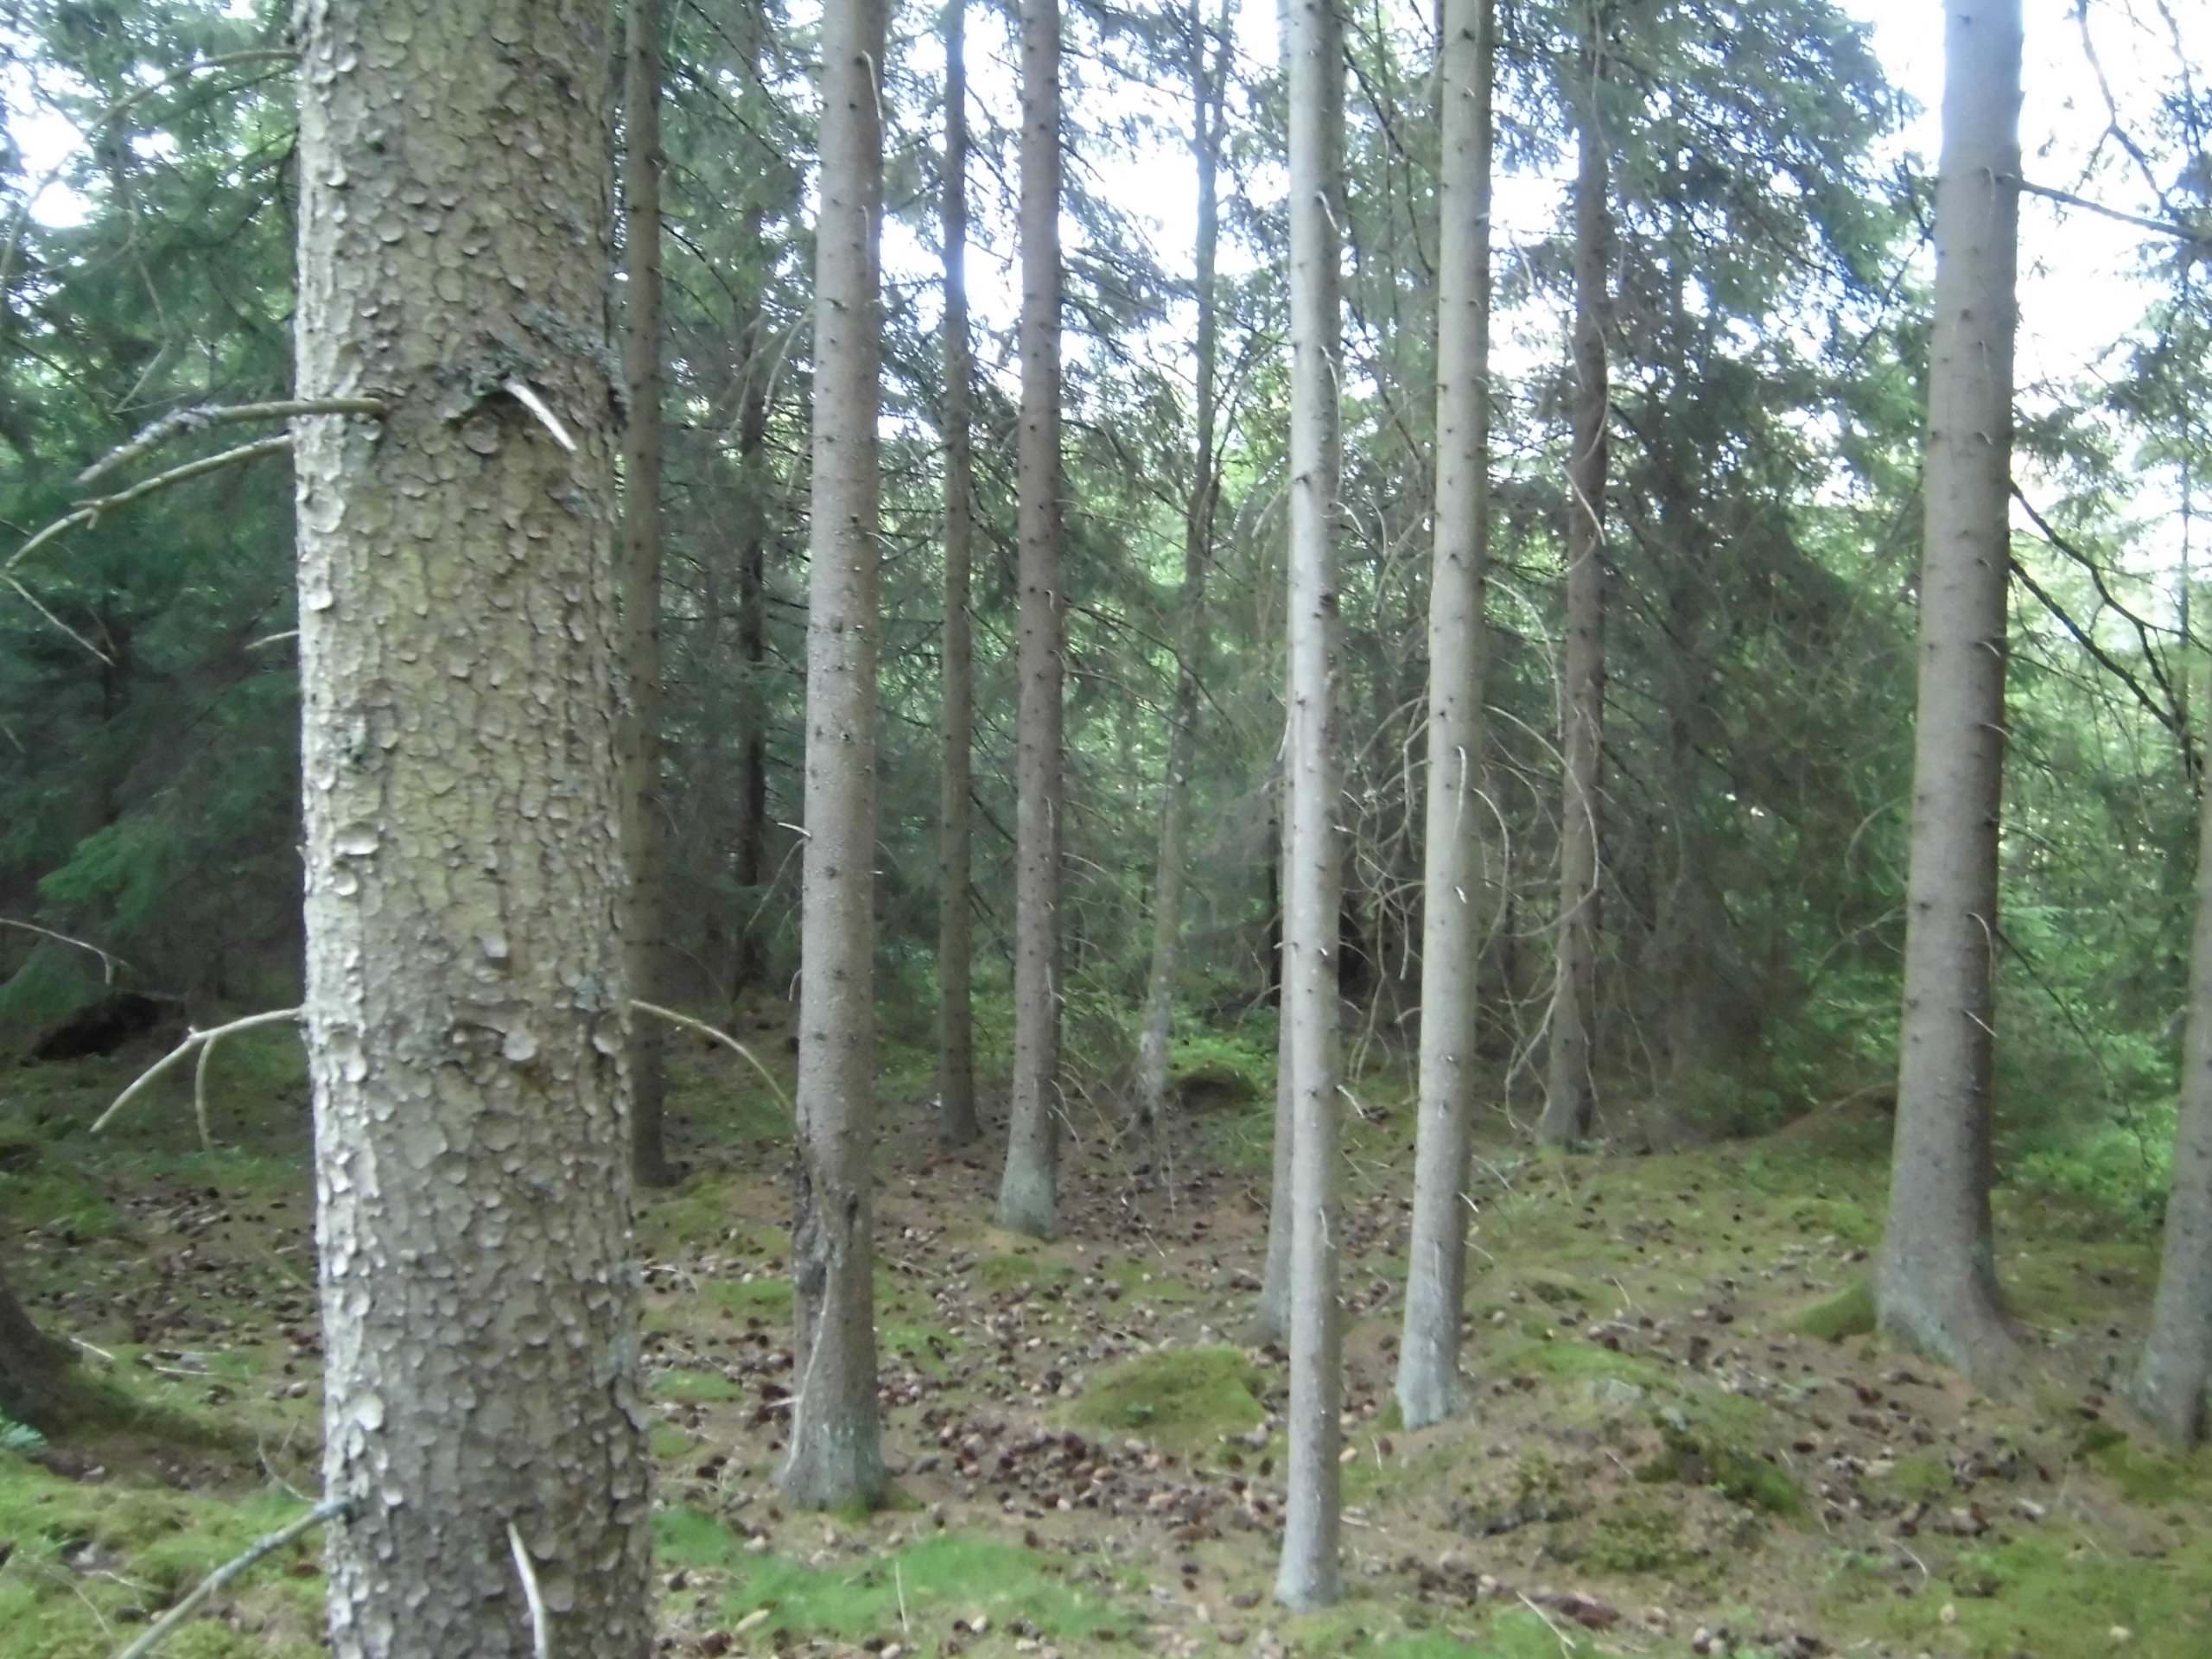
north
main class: Woodland
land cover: Spruce dominated coniferous woodland
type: boreal forest
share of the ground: > 75 %
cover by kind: coniferous forest trees 75 %, lichens and mosses 10 %, broadleaved forest trees 5 %, shrubs 5 %, unconsolidated bare surface 5 %
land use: Forestry
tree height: > 5 m
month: July
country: SE
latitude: 57.3614
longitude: 14.7340
